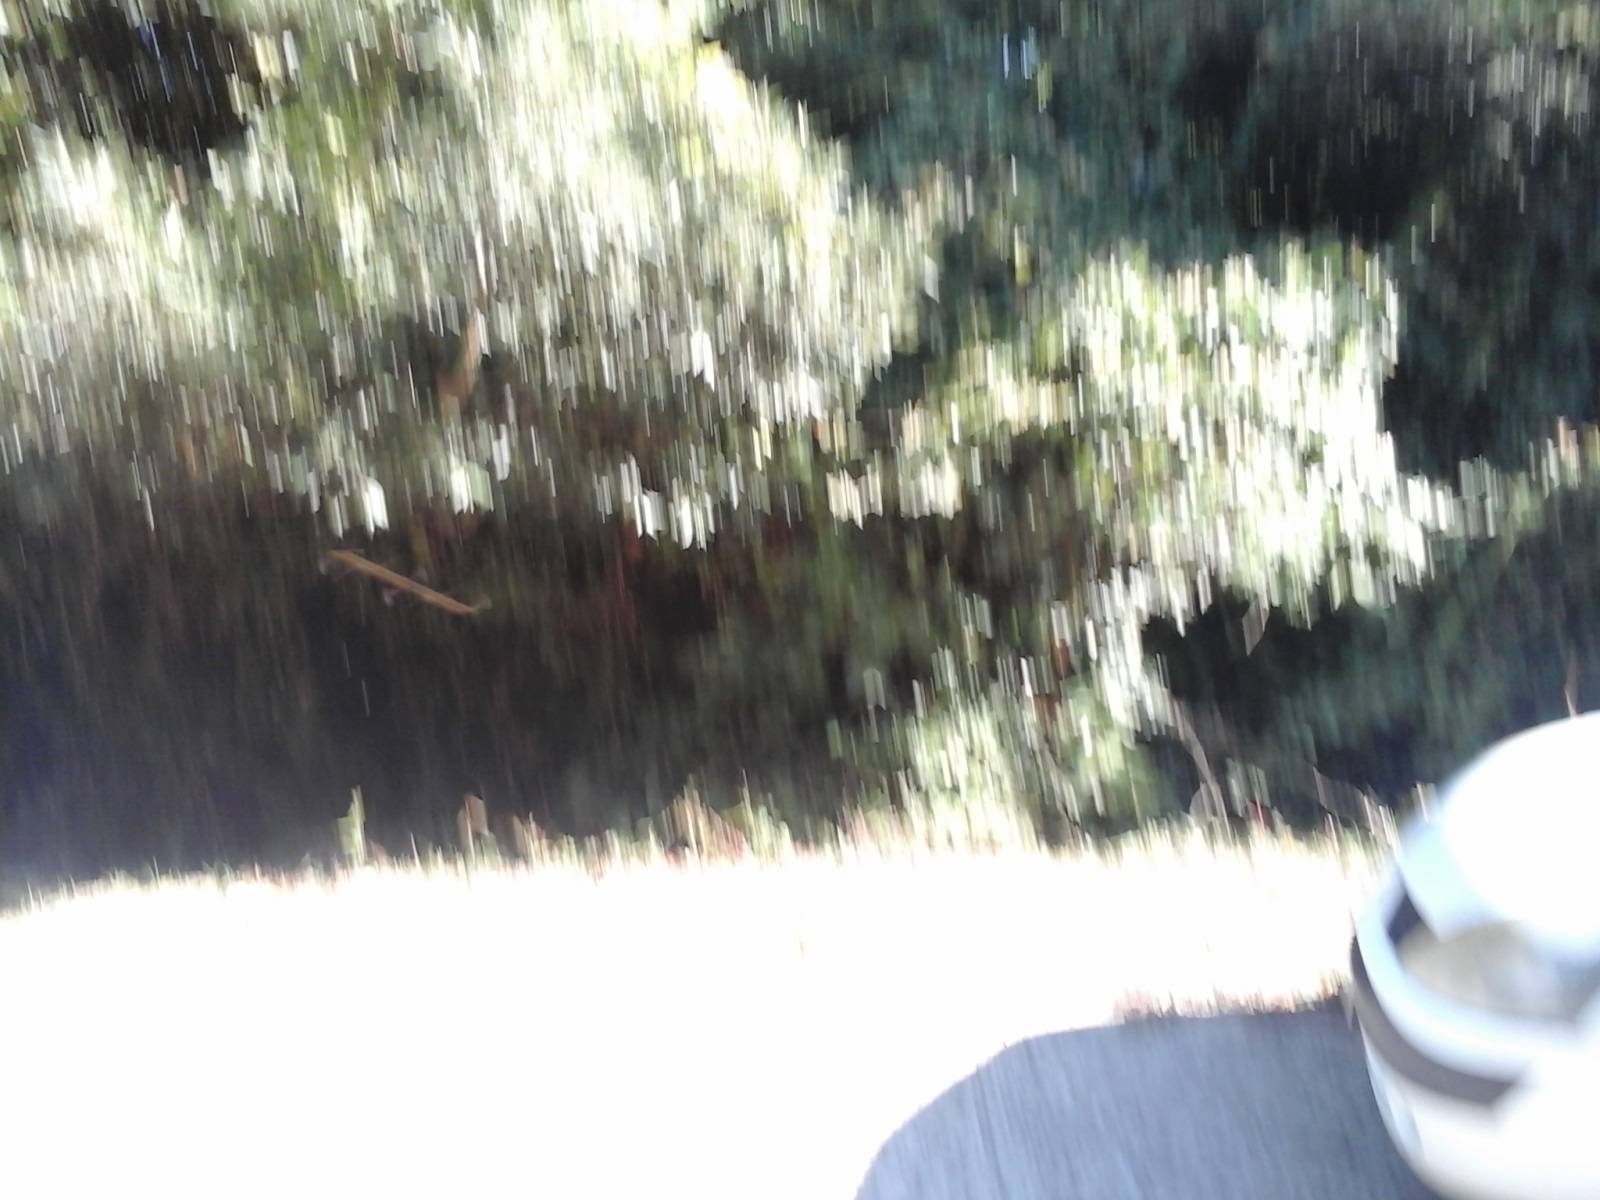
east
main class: Woodland
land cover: Broadleaved woodland
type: broadleaved evergreen forest
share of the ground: > 75 %
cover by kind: broadleaved forest trees 90 %, shrubs 10 %
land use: Semi-natural and natural areas not in use
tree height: > 5 m
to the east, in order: Broadleaved woodland; Paved roads, cycling and walking lanes; Broadleaved woodland; Electric lines; Broadleaved woodland; Permanent crops (only in case pi); Broadleaved woodland
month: October
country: IT
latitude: 40.2028
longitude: 8.5859
